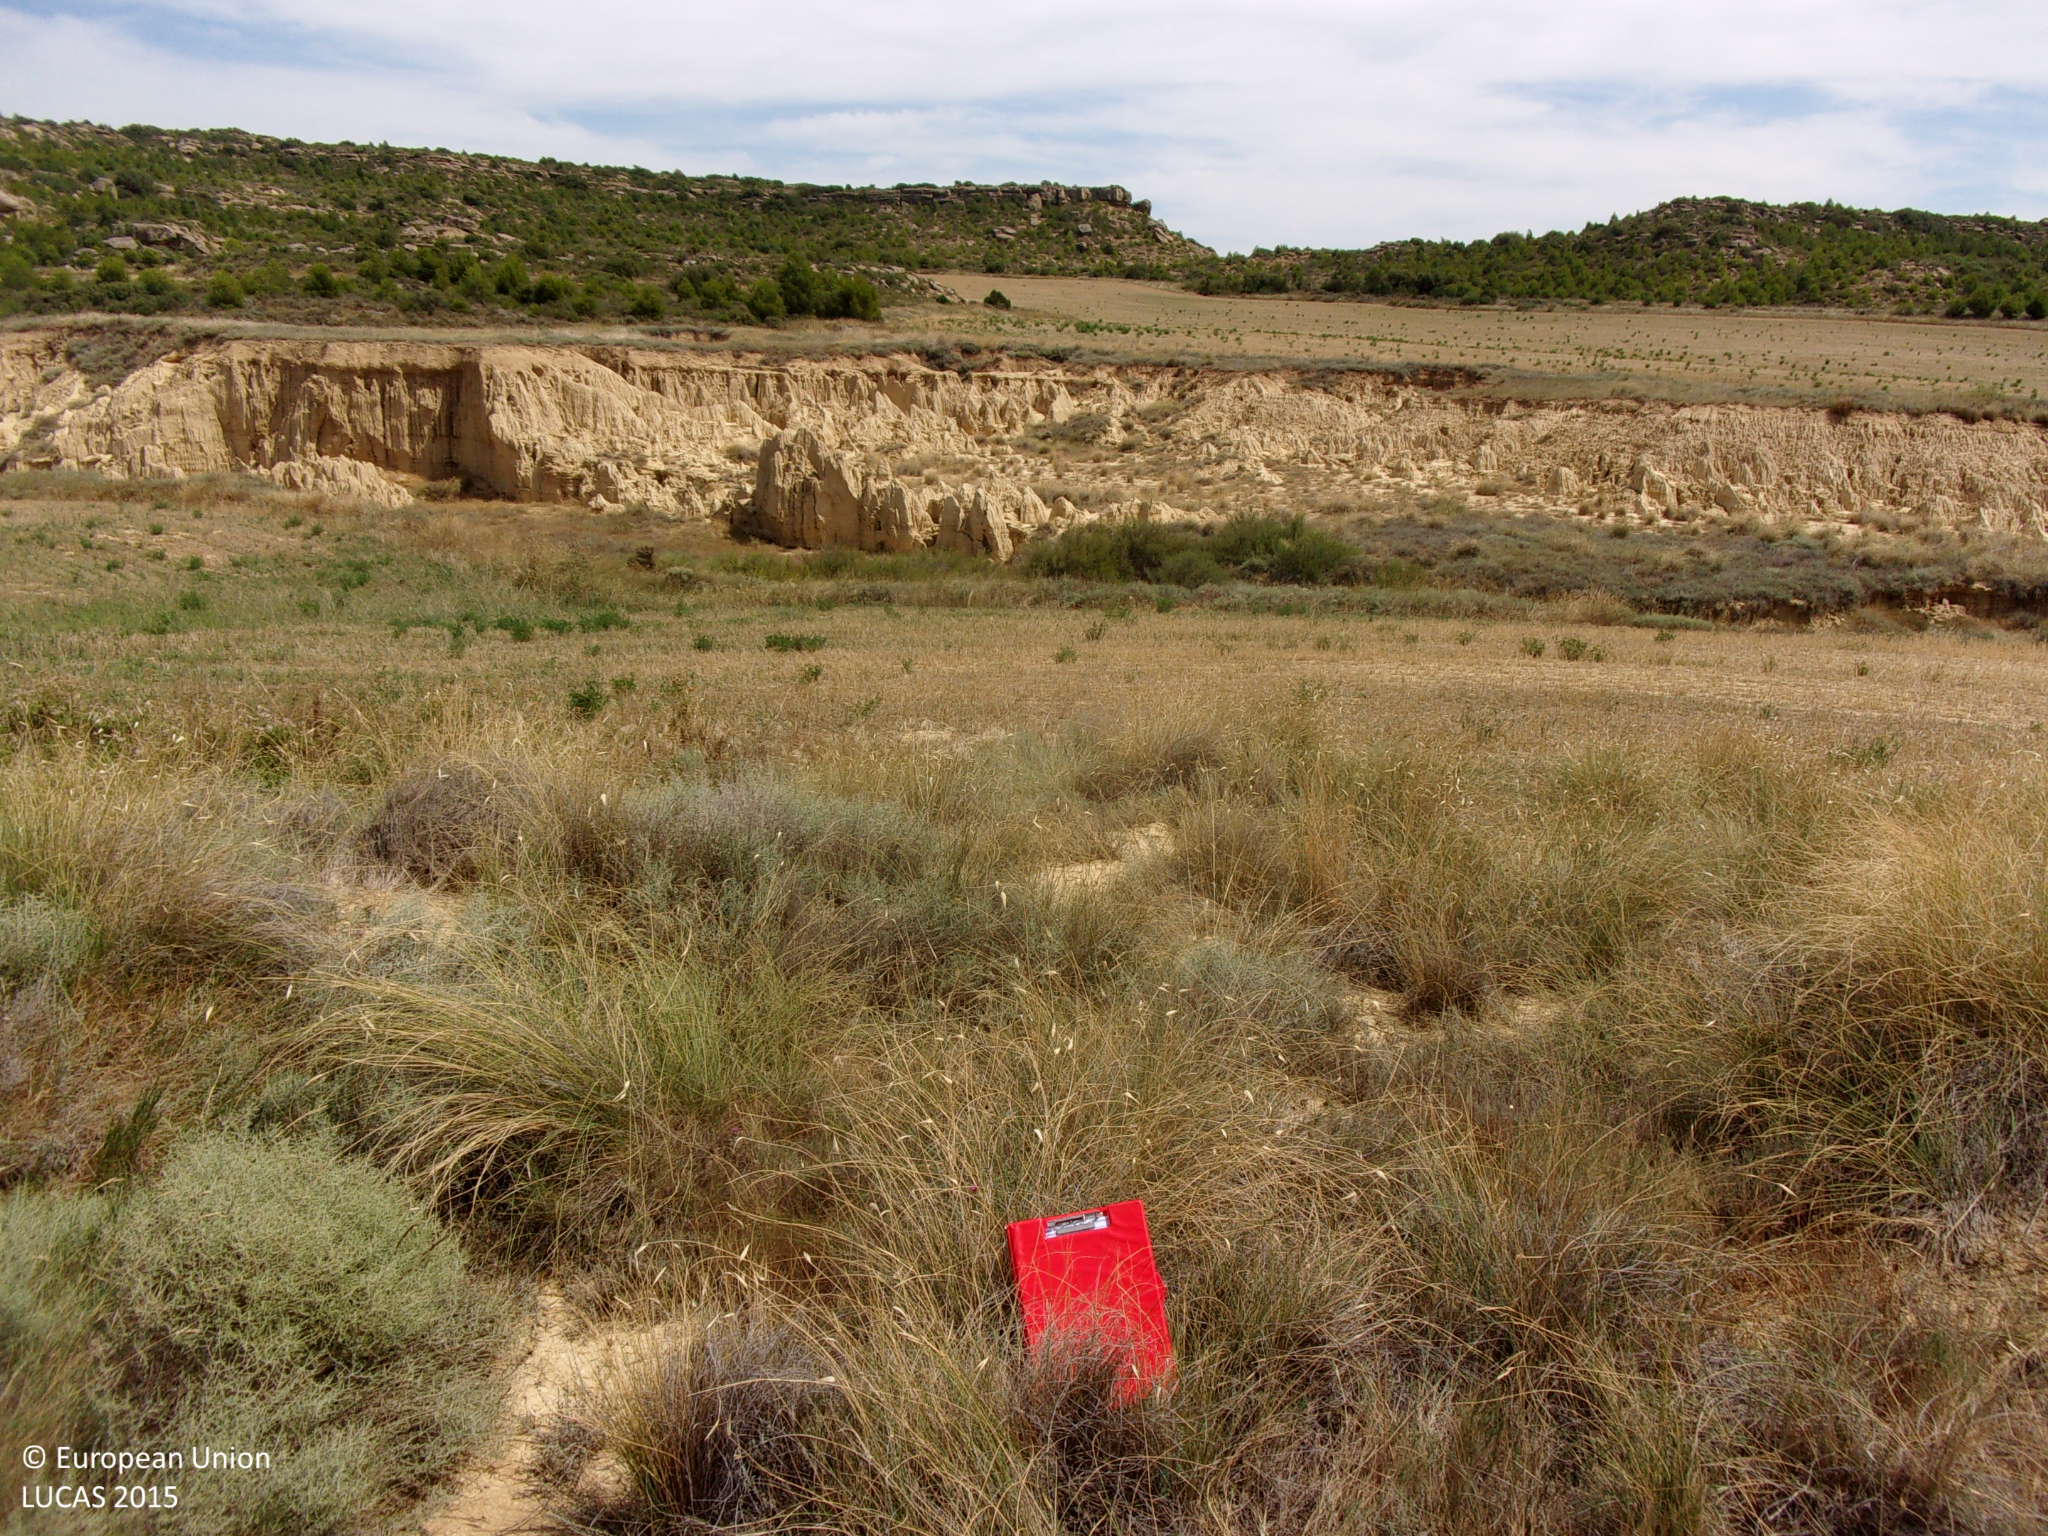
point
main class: Shrubland
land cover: Shrubland without tree cover
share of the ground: > 75 %
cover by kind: shrubs 65 %, herbaceous plants 25 %, consolidated bare surface 10 %
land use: Semi-natural and natural areas not in use
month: August
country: ES
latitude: 42.1743
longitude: -1.0564
